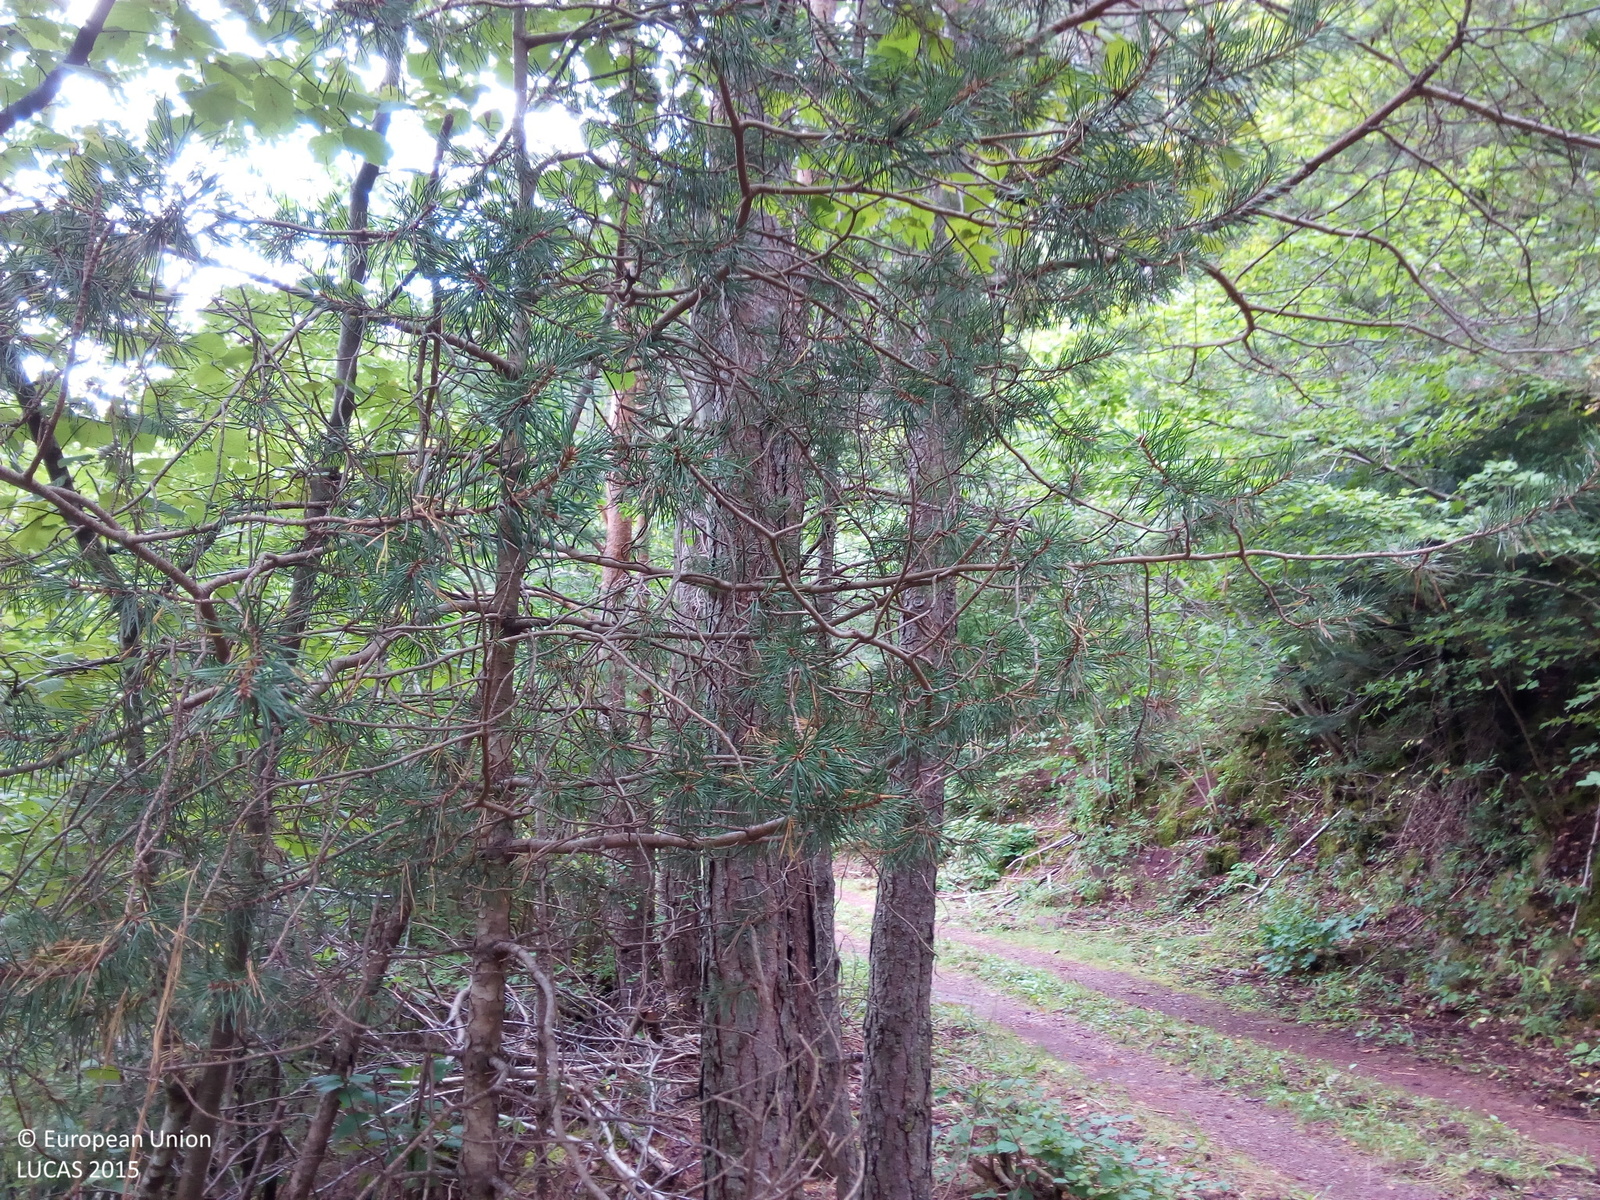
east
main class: Woodland
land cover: Pine dominated mixed woodland
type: alpine coniferous forest
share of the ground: > 75 %
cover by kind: coniferous forest trees 55 %, broadleaved forest trees 45 %
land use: Semi-natural and natural areas not in use
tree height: > 5 m
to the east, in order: Pine dominated mixed woodland; Tracks; Pine dominated mixed woodland
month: September
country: ES
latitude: 42.6176
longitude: 0.2370
